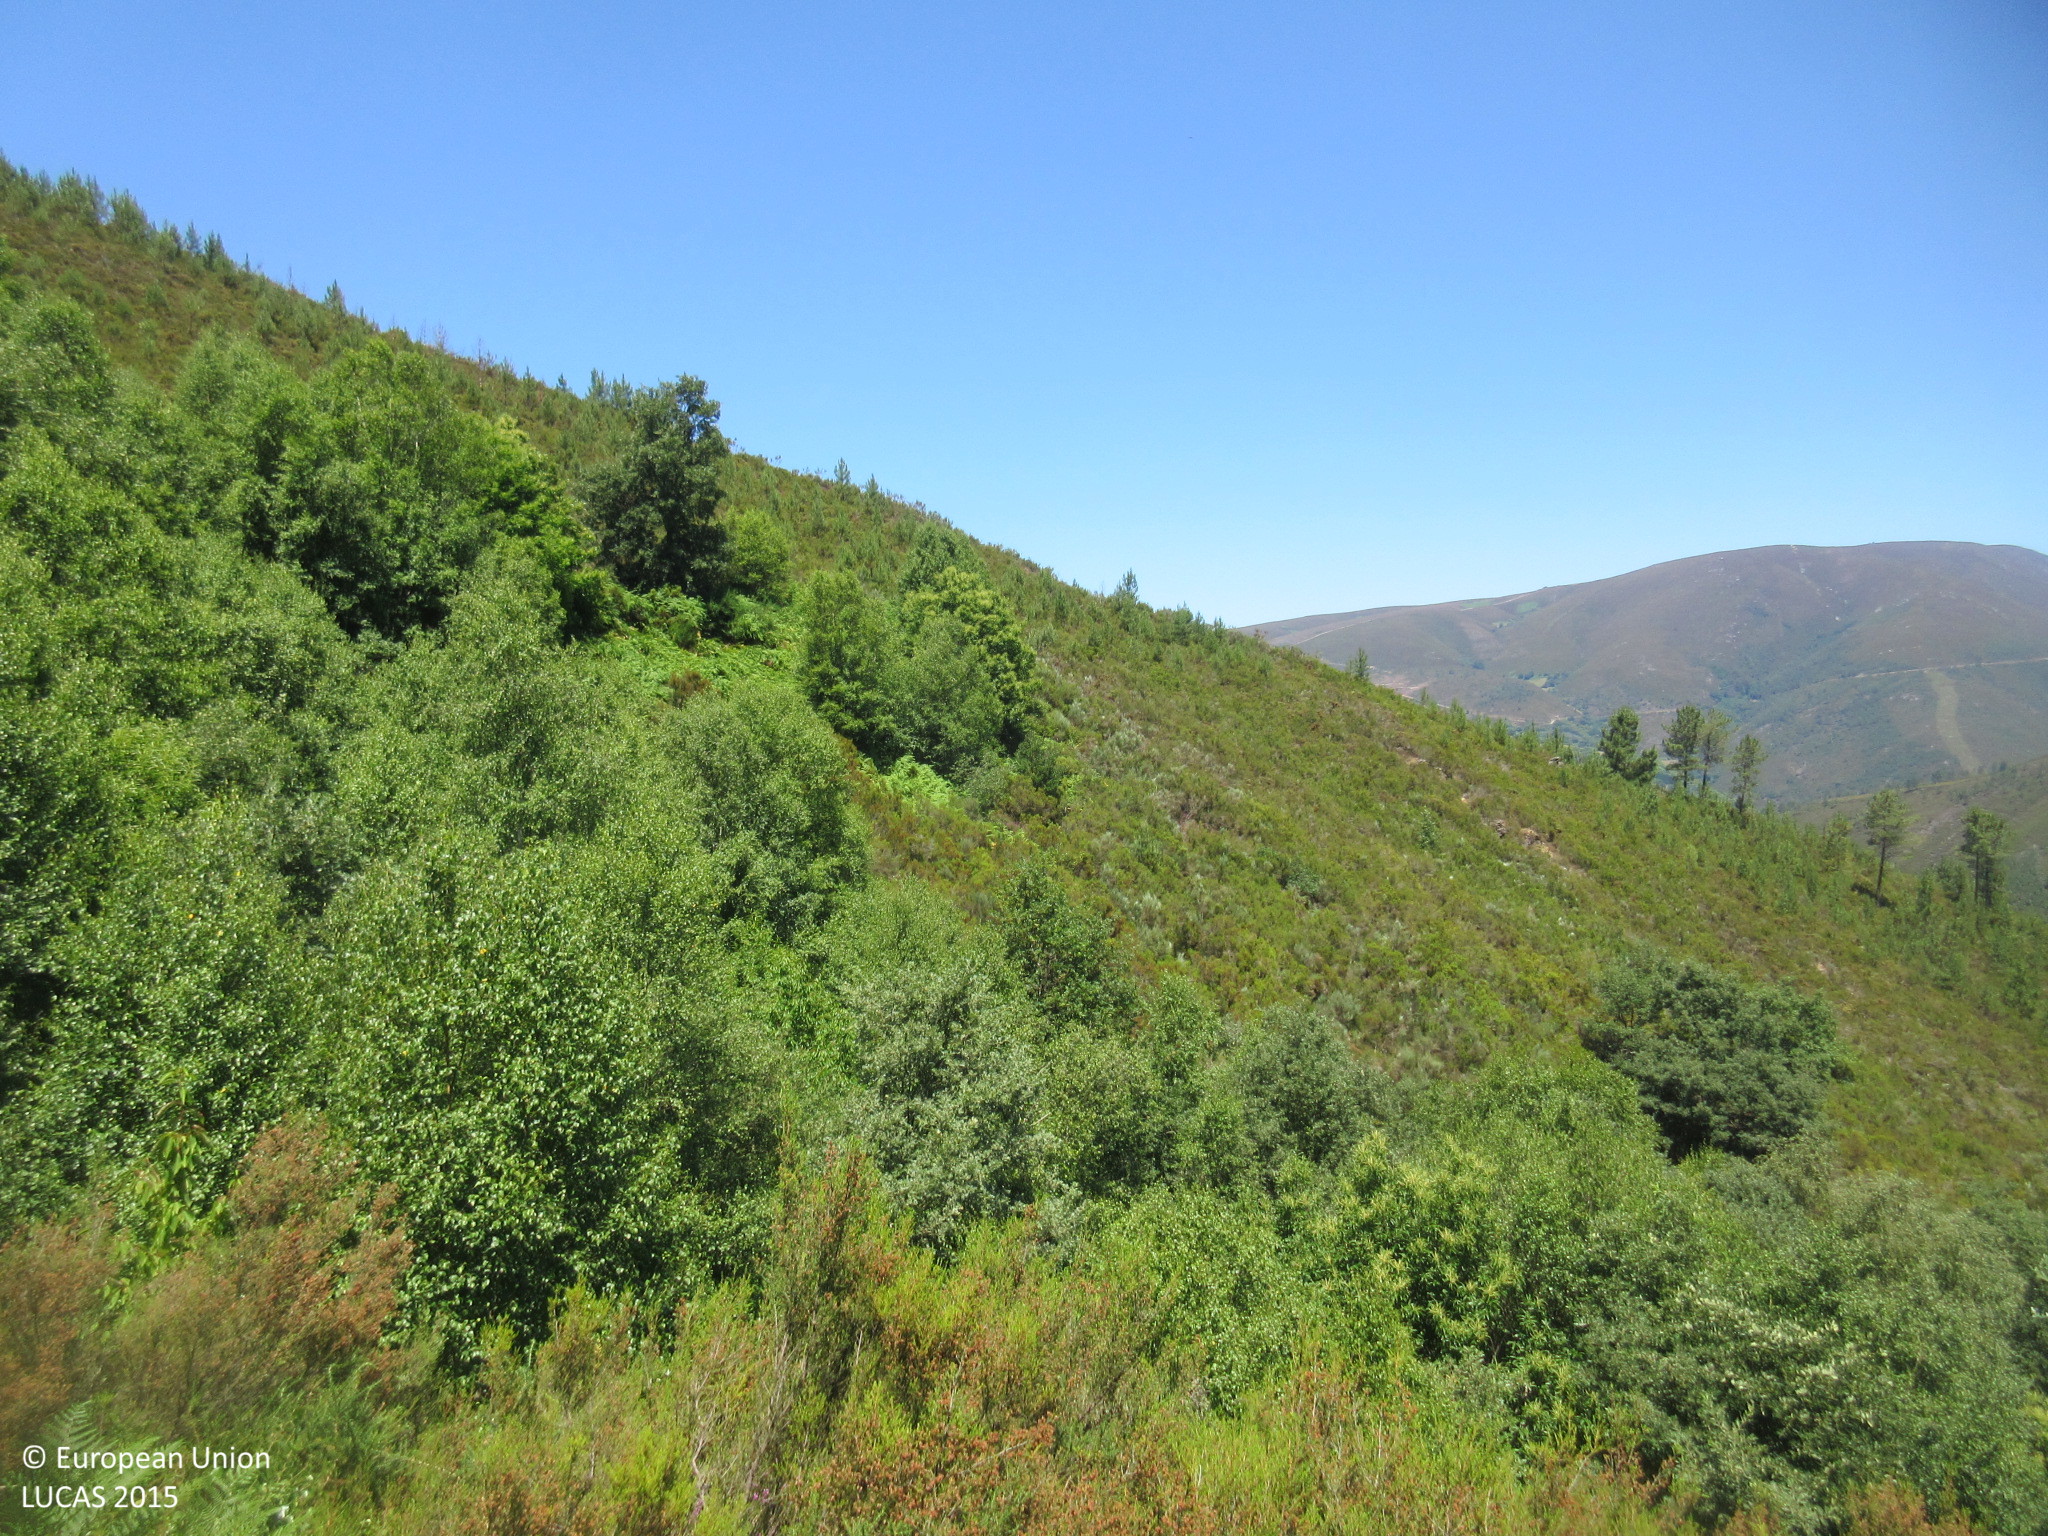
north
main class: Shrubland
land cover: Shrubland without tree cover
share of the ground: > 75 %
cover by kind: shrubs 100 %
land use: Forestry
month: June
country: ES
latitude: 43.0538
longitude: -6.8420
